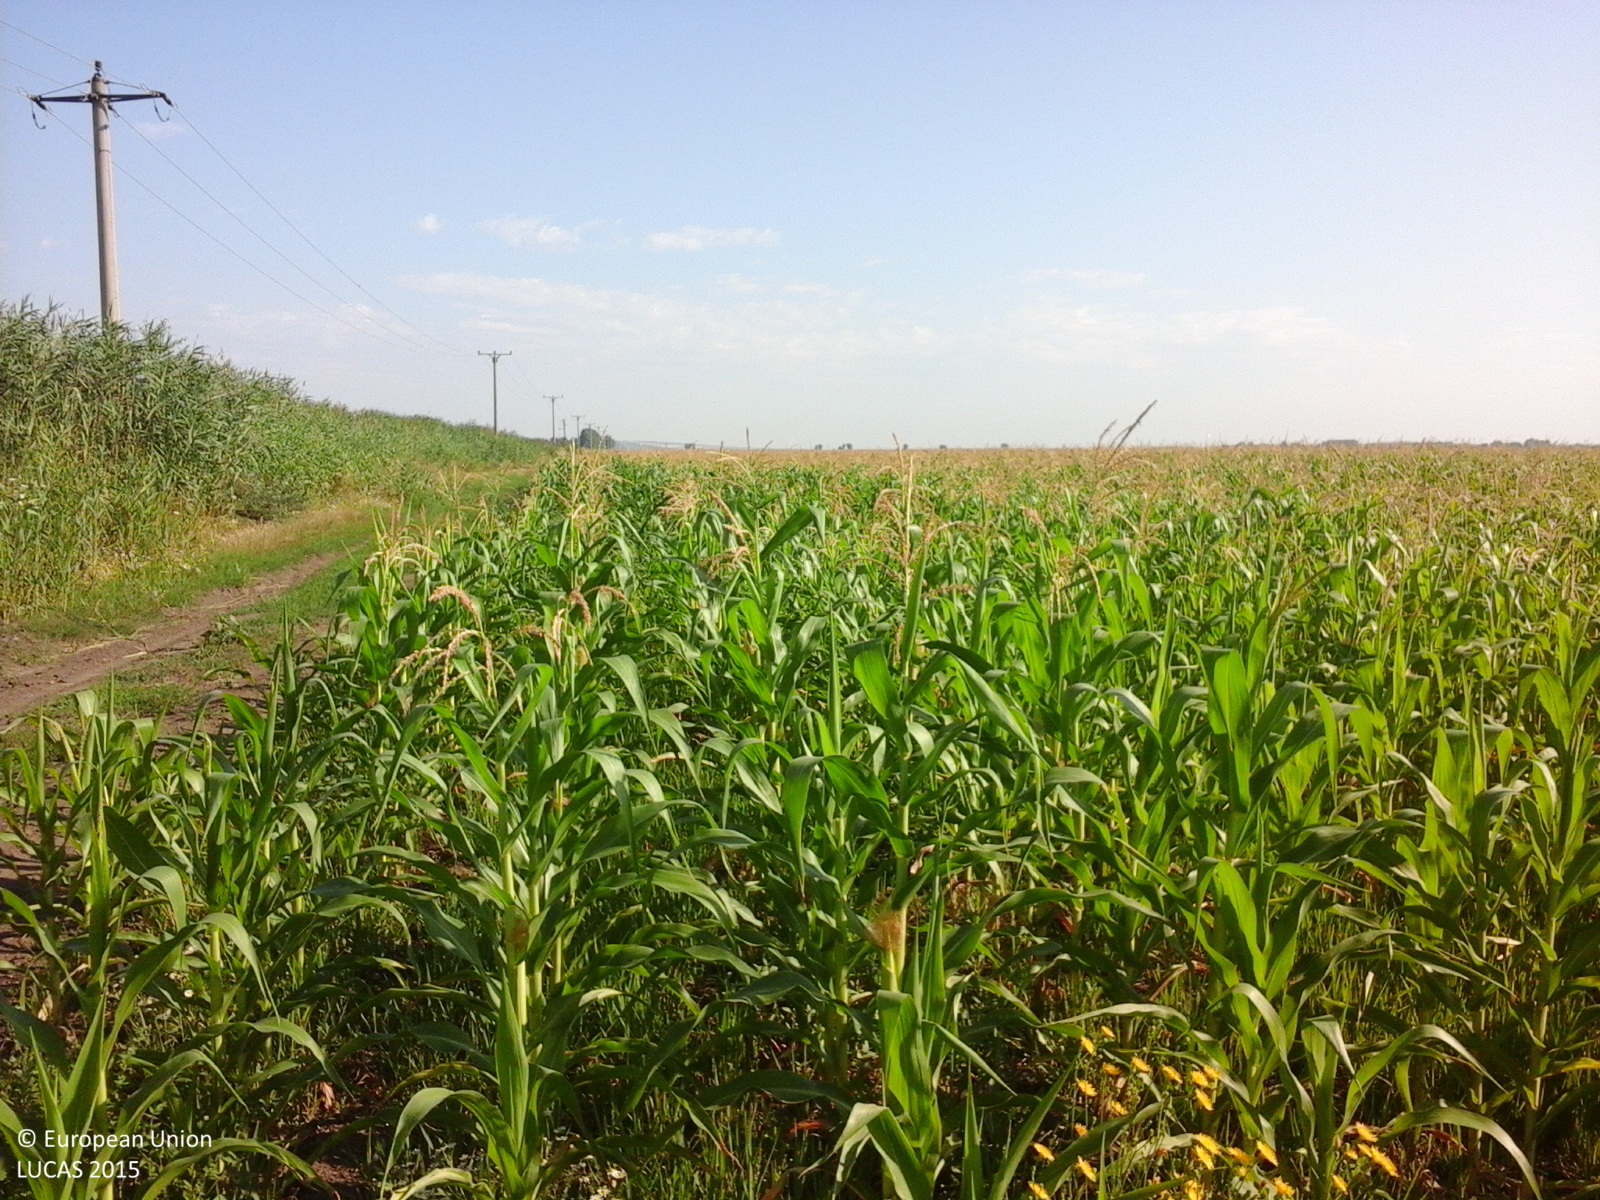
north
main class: Cropland
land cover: Maize
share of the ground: > 75 %
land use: Agriculture (excluding fallow land and kitchen gardens)
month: July
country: RO
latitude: 46.3269
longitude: 28.1725
